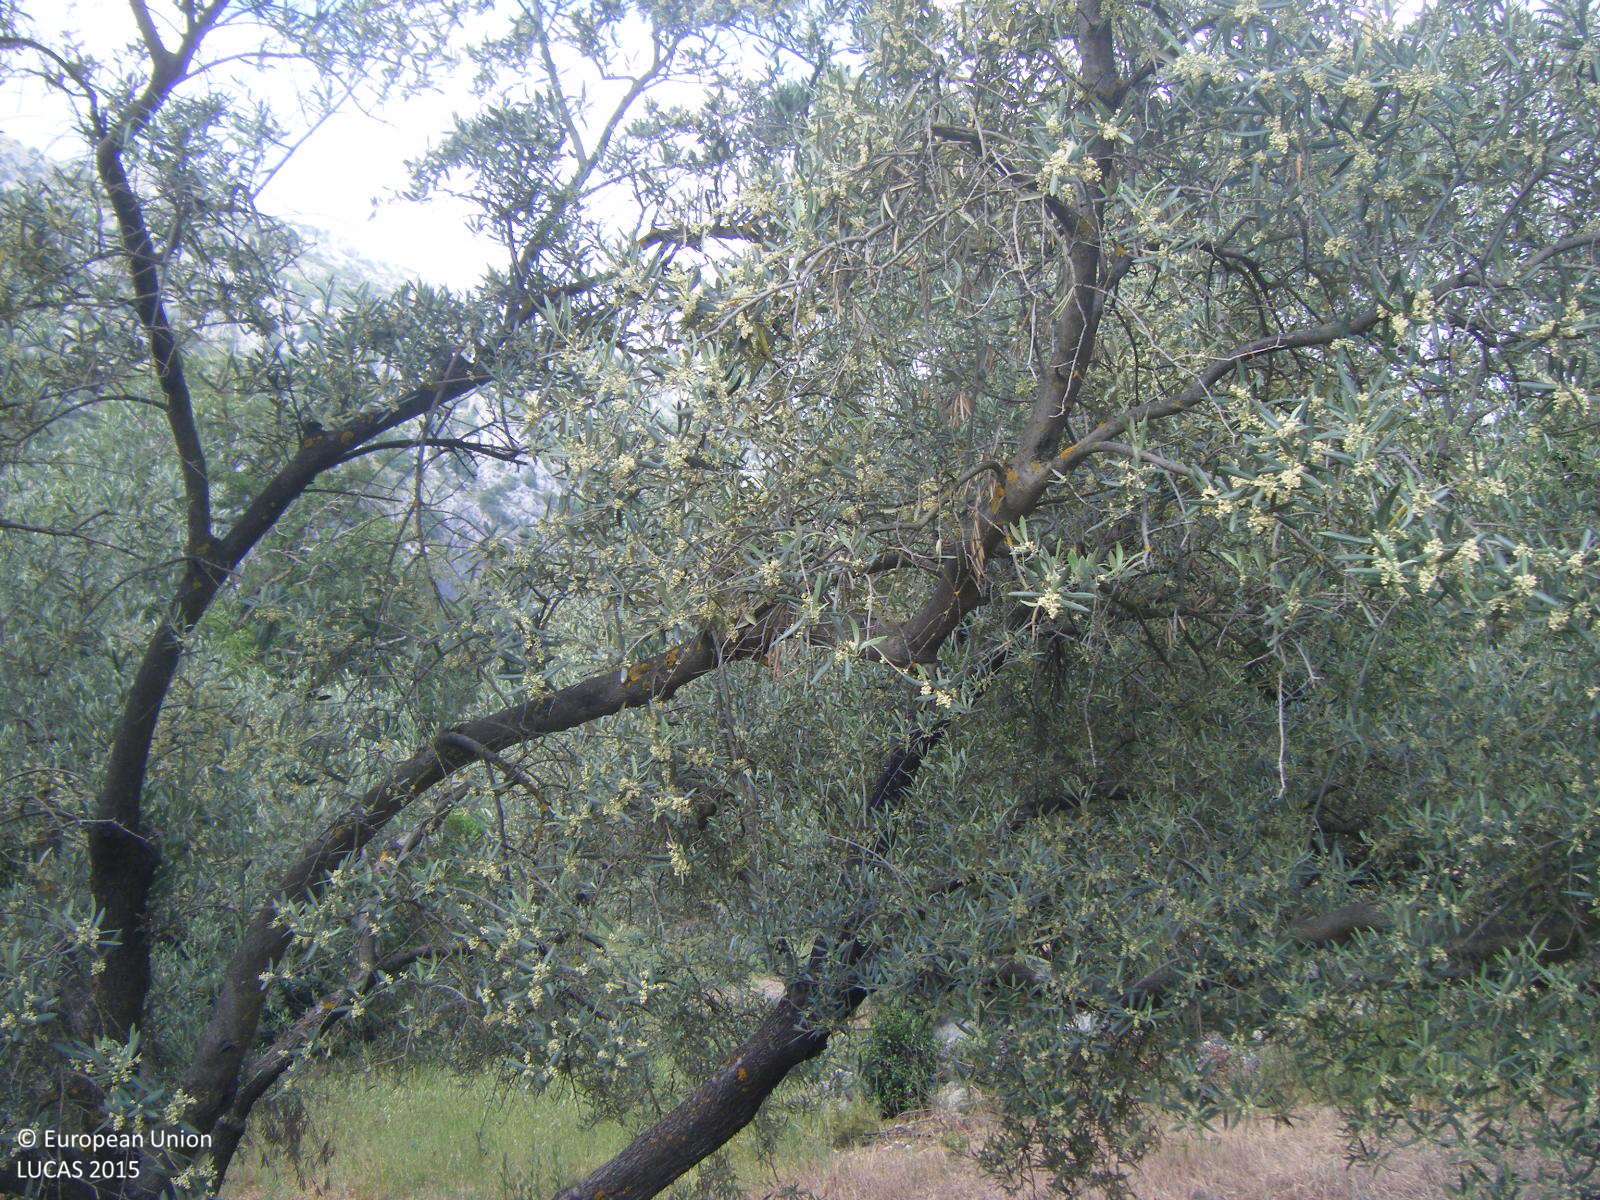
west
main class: Cropland
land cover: Olive groves
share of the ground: 10 - 25 %
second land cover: Spontaneously vegetated surfaces
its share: > 75 %
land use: Agriculture (excluding fallow land and kitchen gardens)
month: May
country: ES
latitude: 36.9855
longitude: -4.3406
